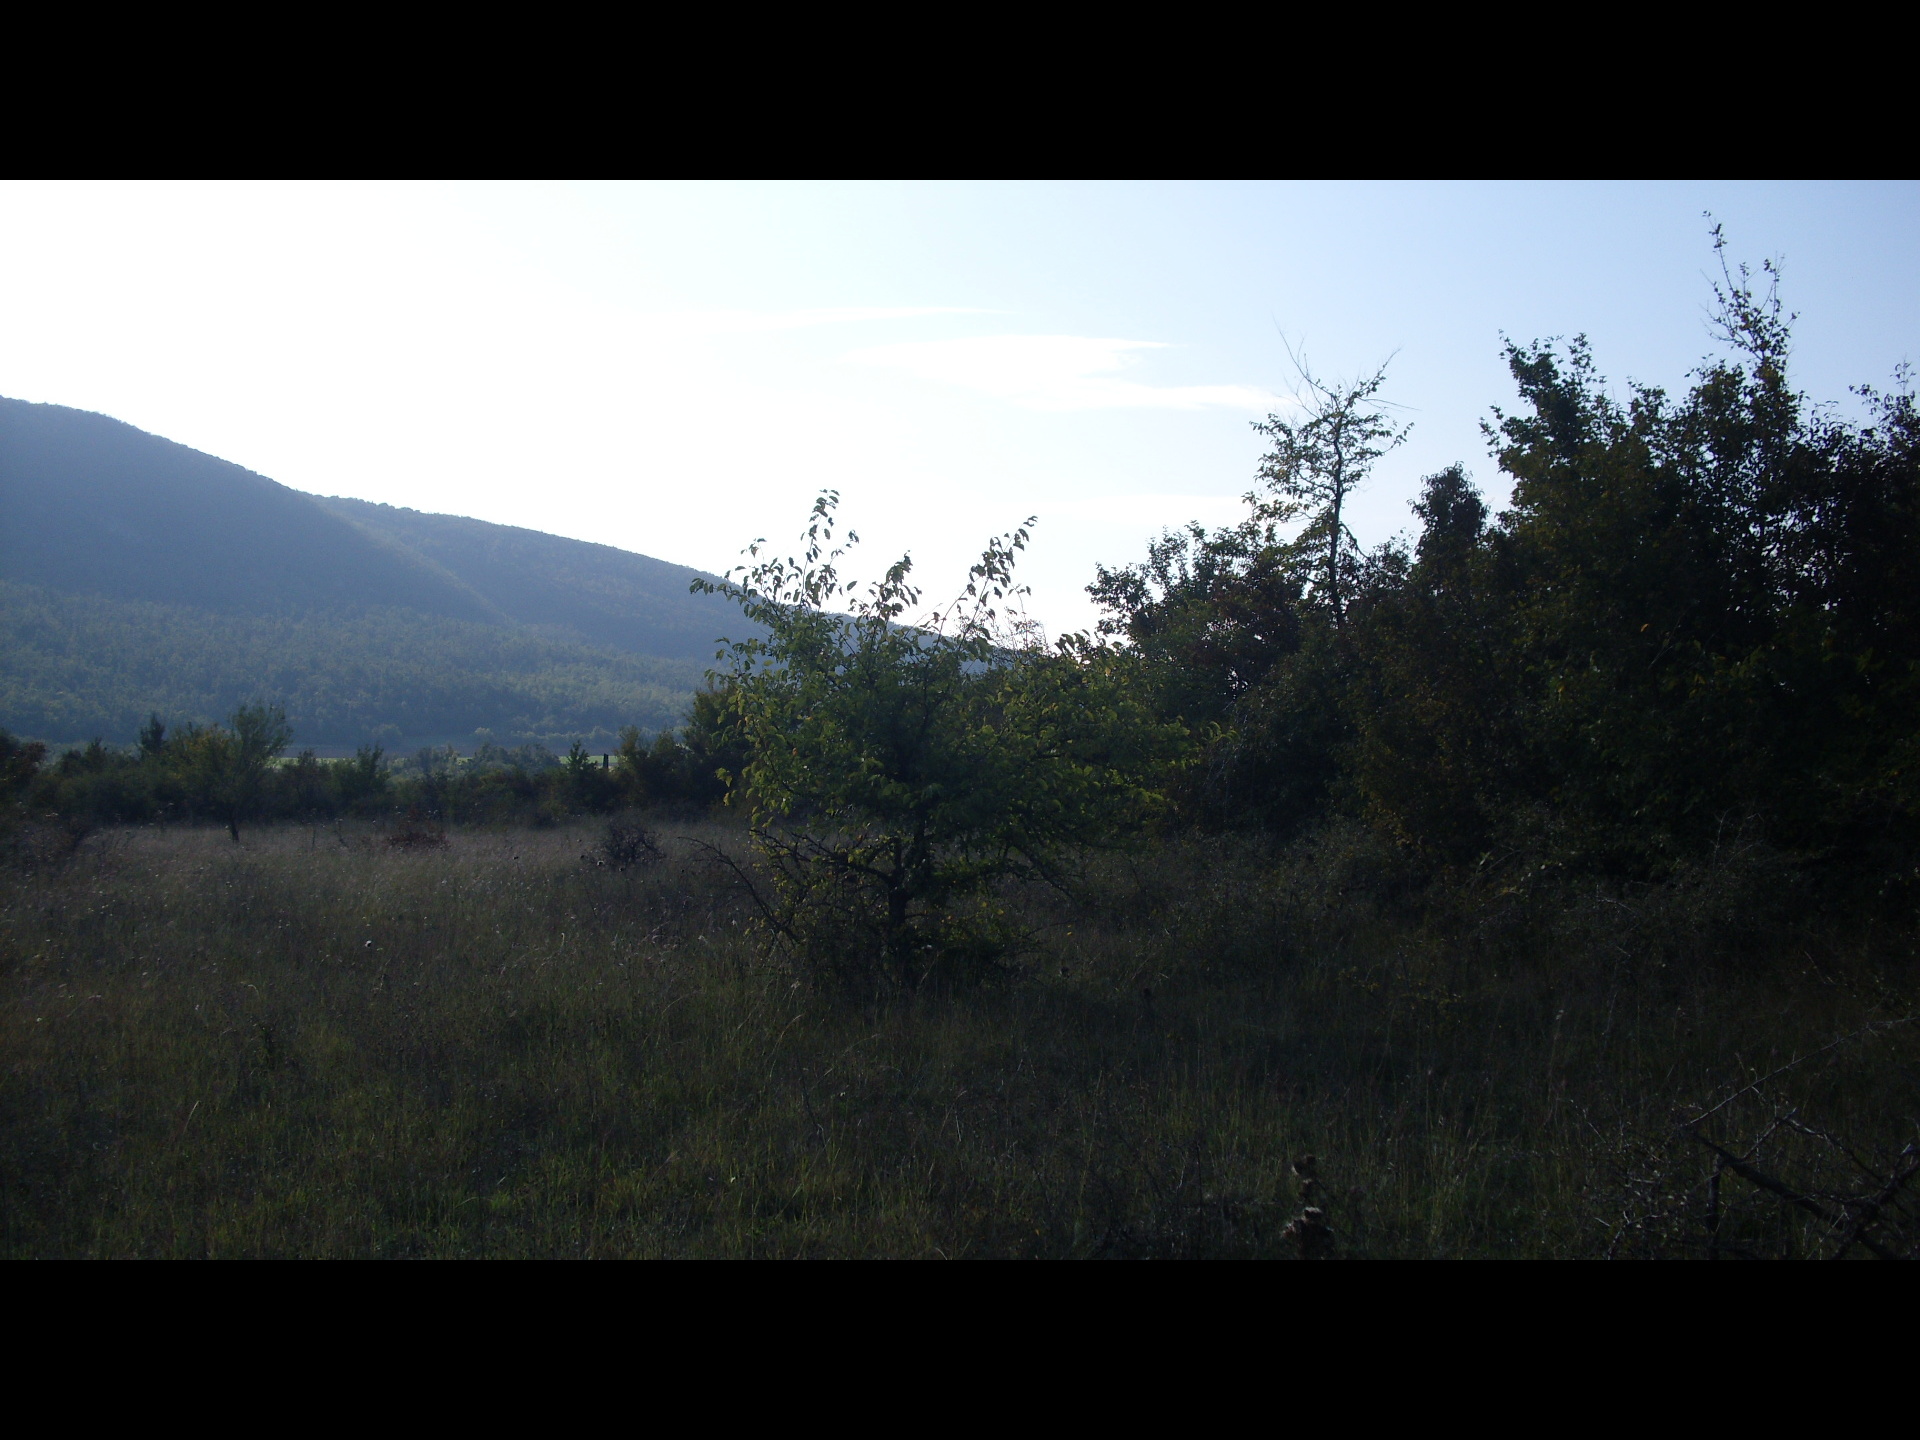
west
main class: Shrubland
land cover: Shrubland with sparse tree cover
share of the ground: > 75 %
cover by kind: shrubs 75 %, herbaceous plants 20 %, broadleaved forest trees 5 %
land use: Semi-natural and natural areas not in use
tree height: < 5 m
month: October
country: BG
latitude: 43.8428
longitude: 22.3827
